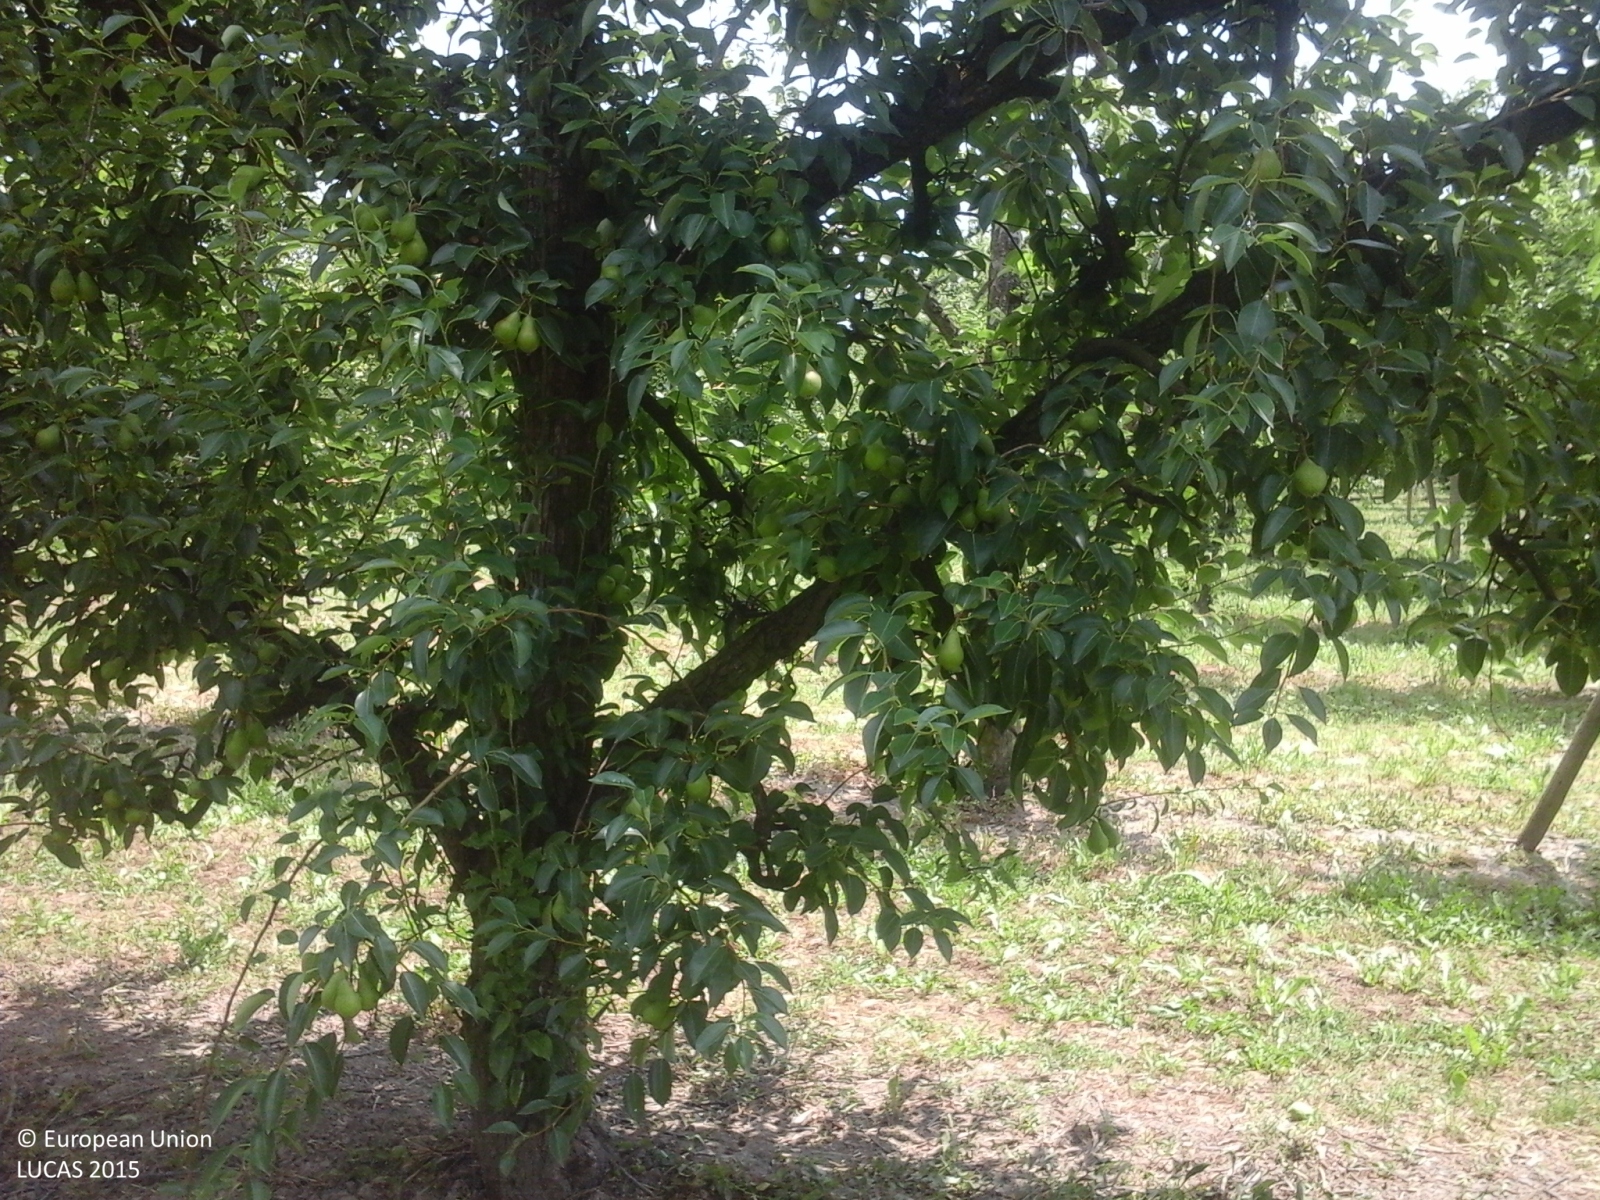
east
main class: Cropland
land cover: Pear fruit
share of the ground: > 75 %
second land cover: Grassland without tree/shrub cover
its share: > 75 %
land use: Agriculture (excluding fallow land and kitchen gardens)
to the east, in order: Pear fruit; Grassland without tree/shrub cover; Tracks; Pear fruit
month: June
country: IT
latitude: 44.7969
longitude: 10.9714
